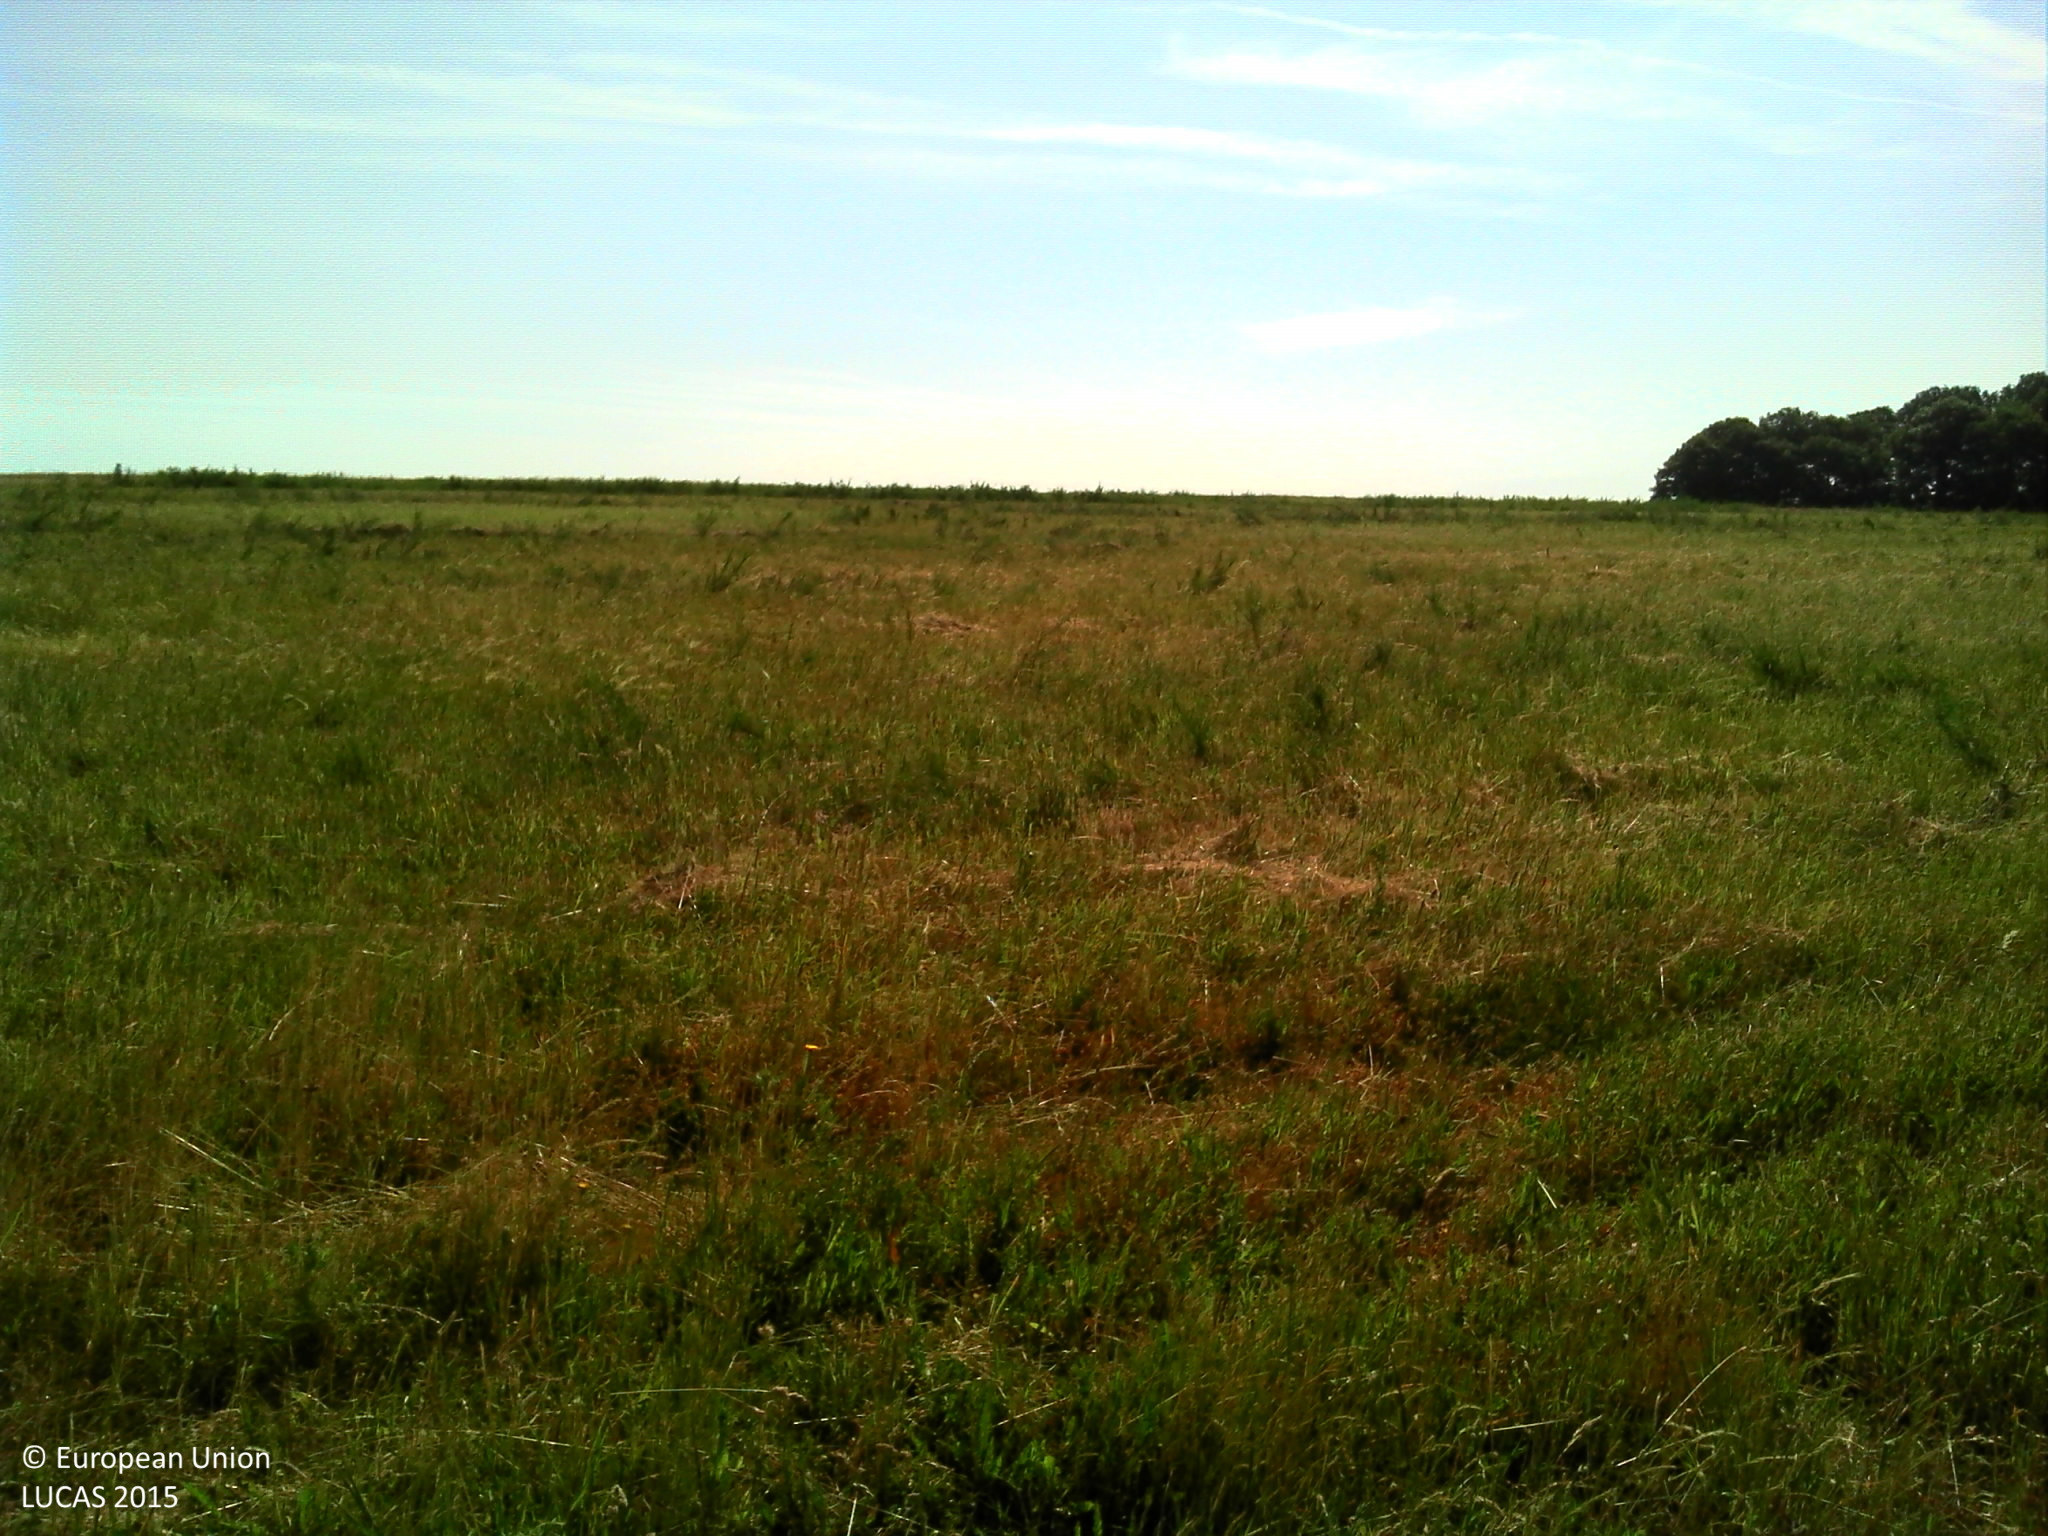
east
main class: Cropland
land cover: Rape and turnip rape
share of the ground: > 75 %
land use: Agriculture (excluding fallow land and kitchen gardens)
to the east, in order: Rape and turnip rape; Grassland without tree/shrub cover
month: June
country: FR
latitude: 47.1108
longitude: 2.6535
